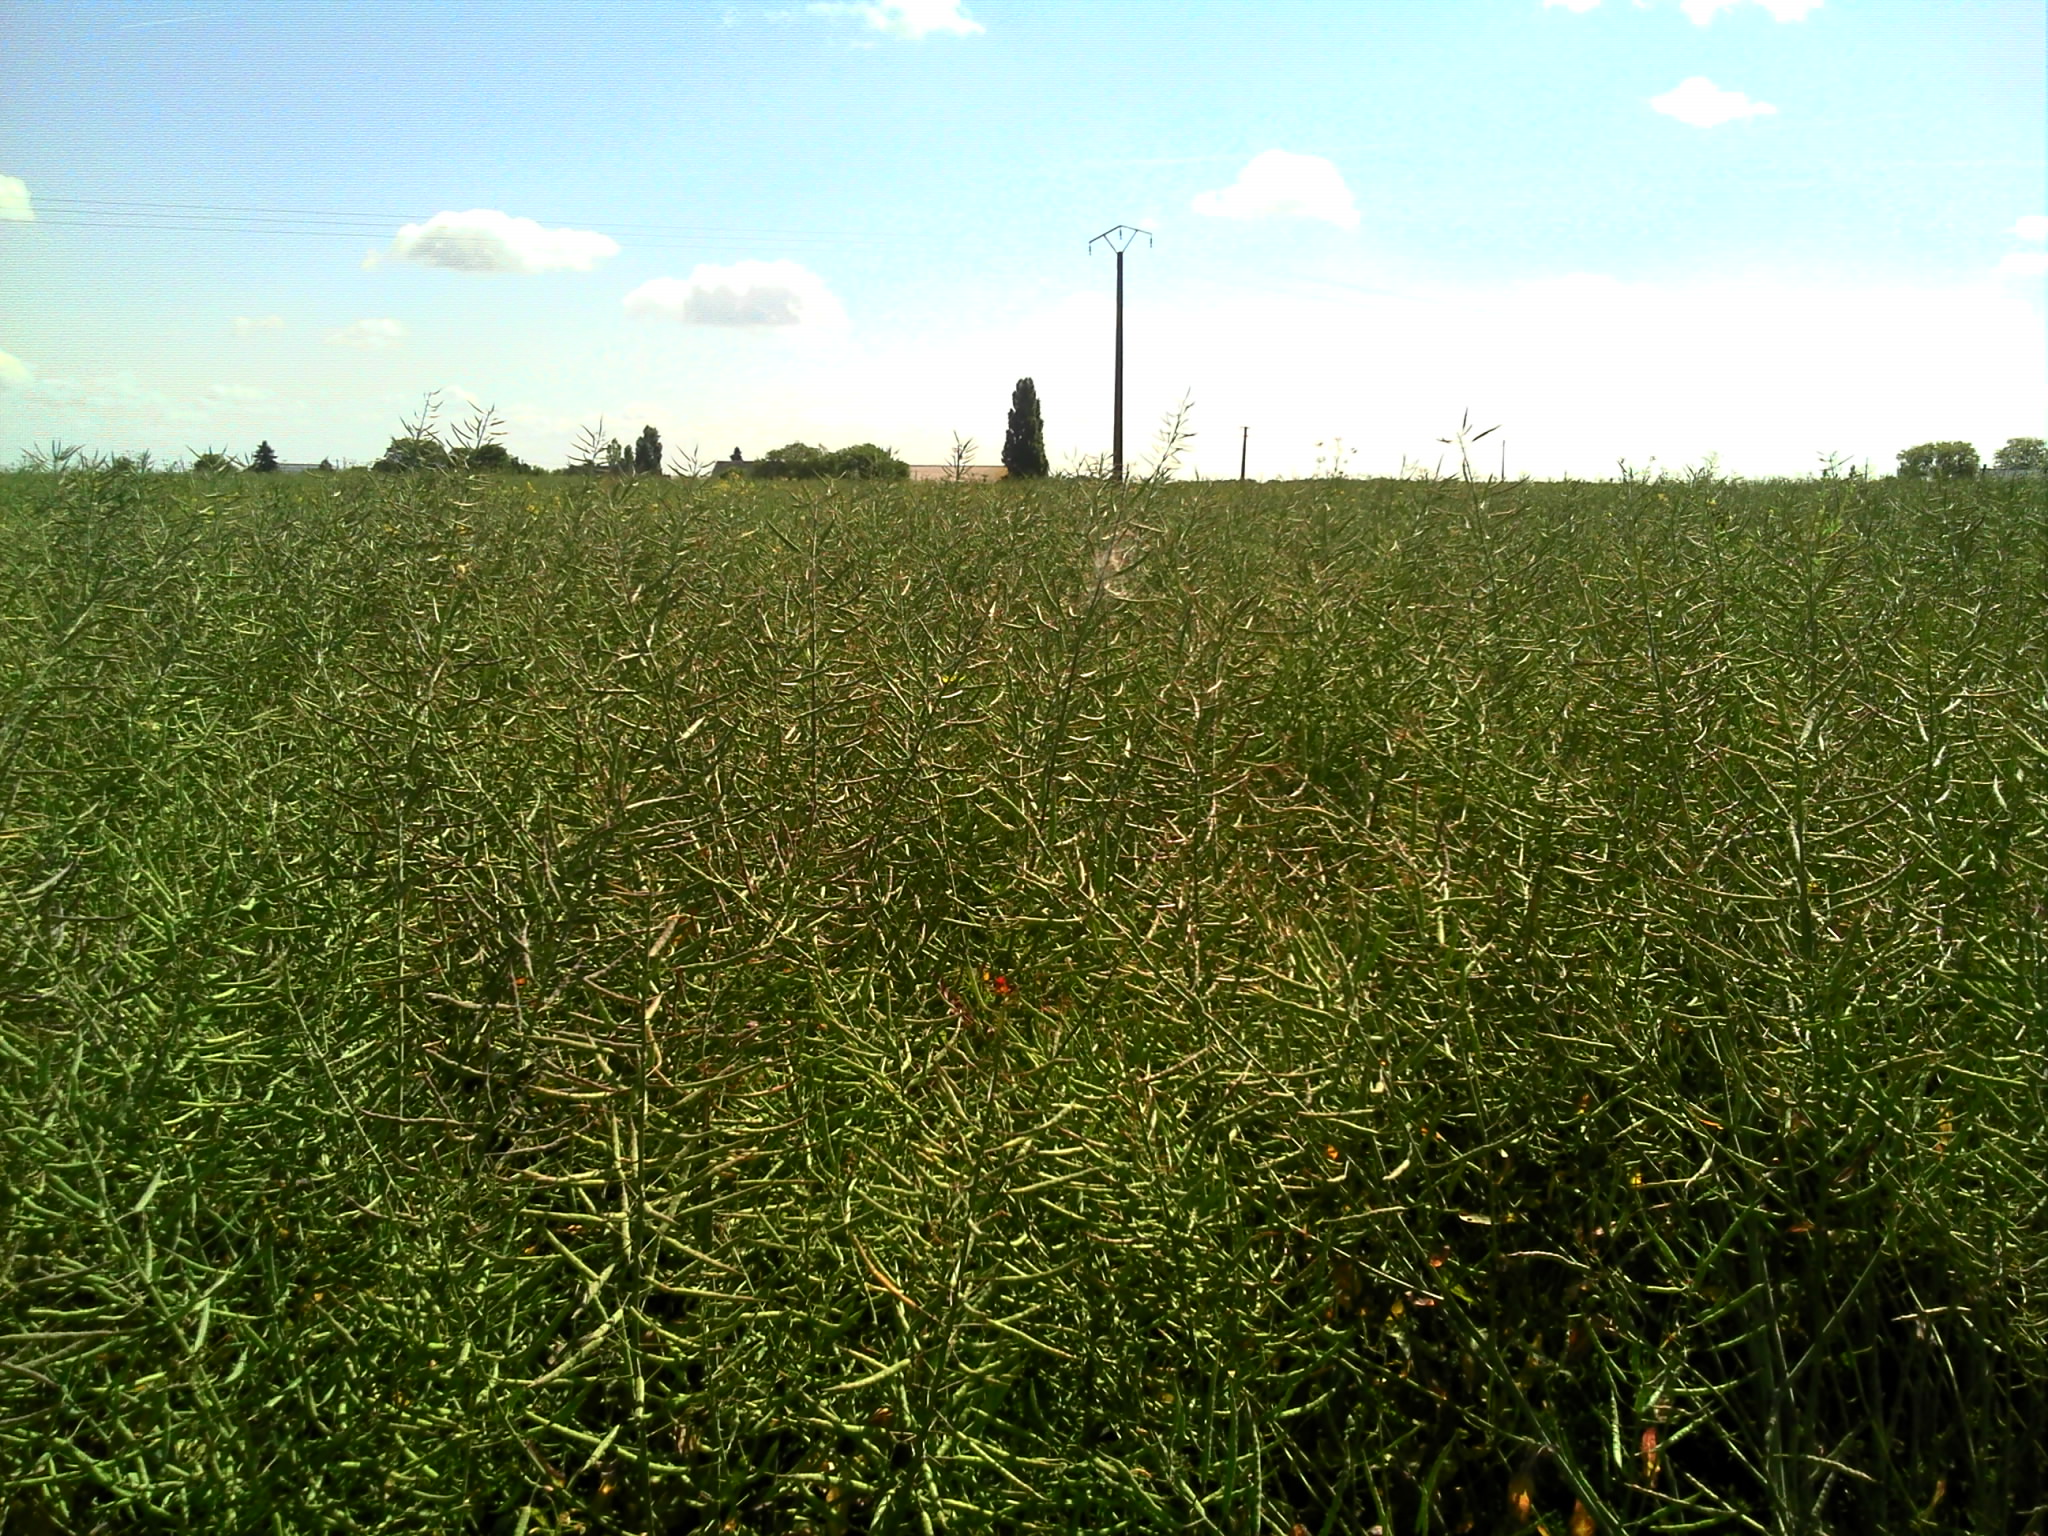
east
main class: Cropland
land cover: Rape and turnip rape
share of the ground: > 75 %
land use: Agriculture (excluding fallow land and kitchen gardens)
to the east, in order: Rape and turnip rape
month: May
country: FR
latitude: 47.0247
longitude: 0.2020
